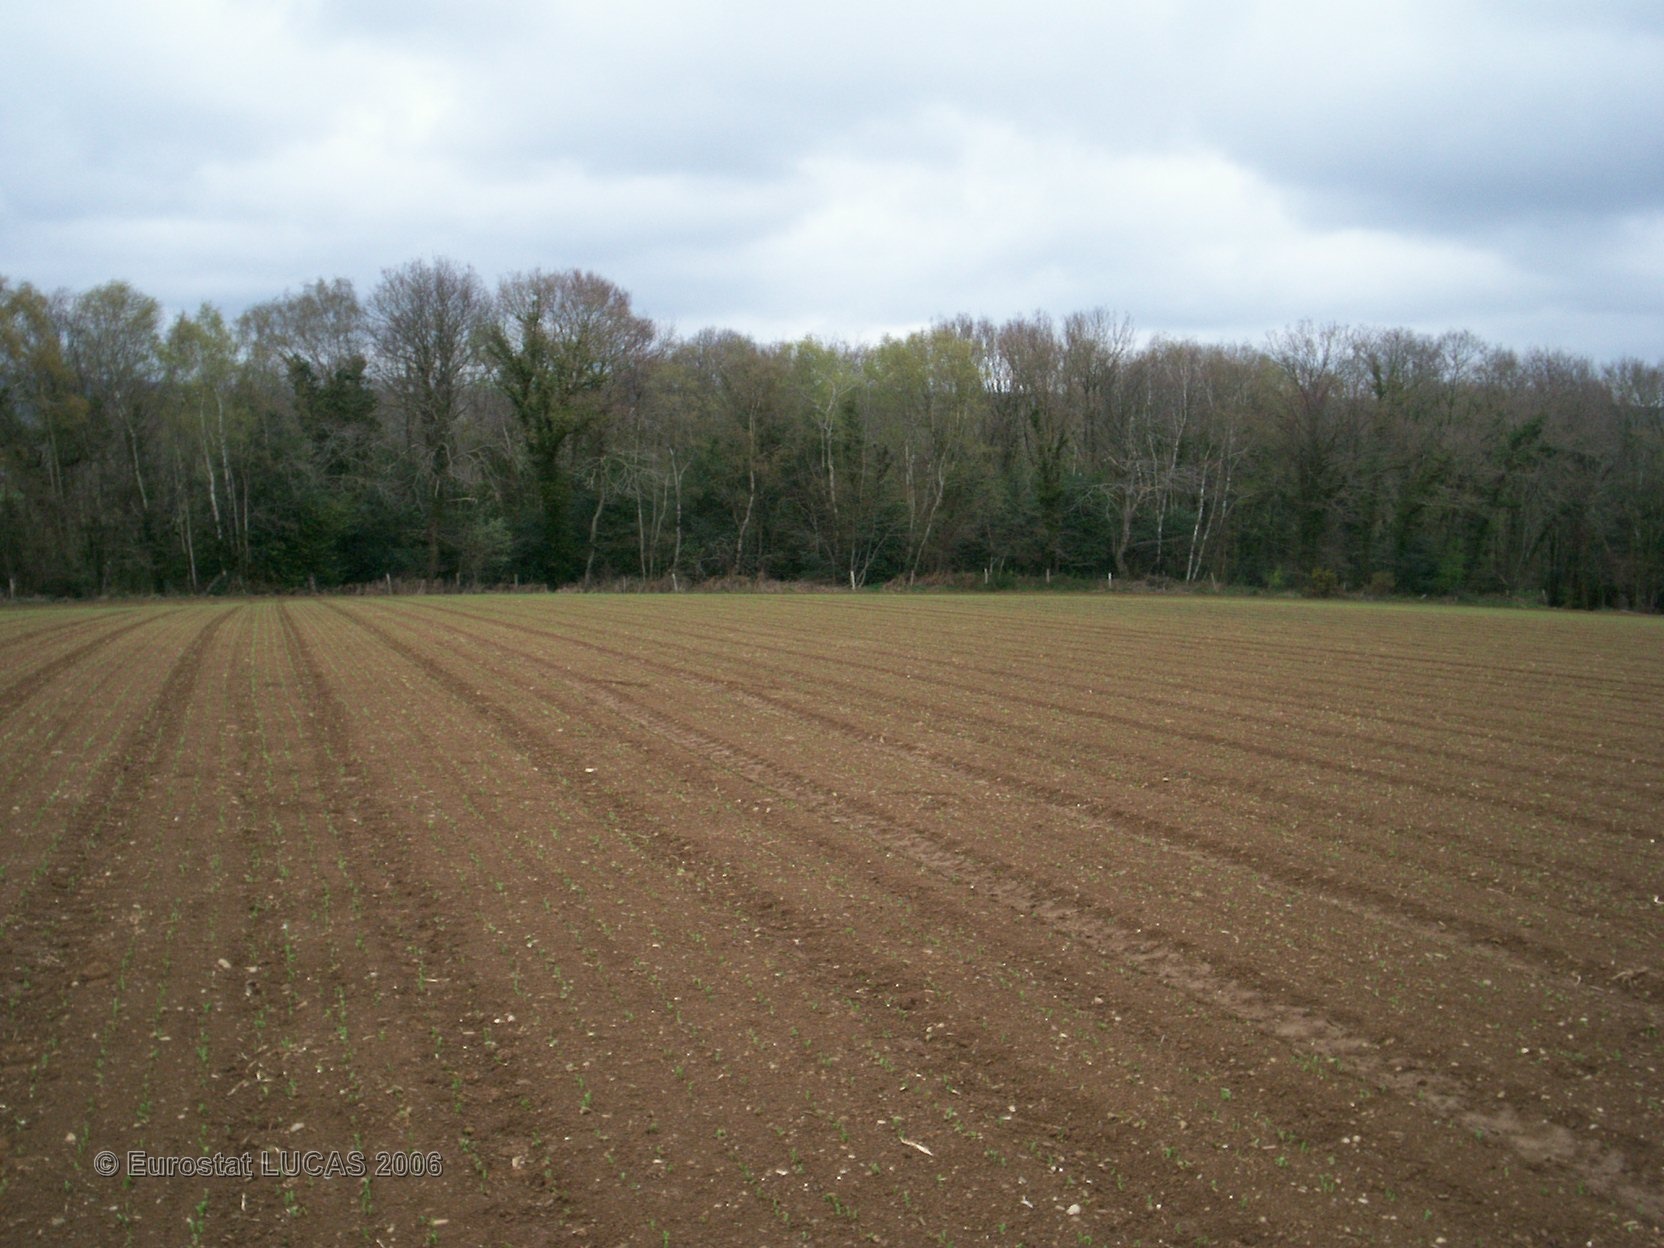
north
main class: Cropland
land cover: Other fresh vegetables
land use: Agriculture (excluding fallow land and kitchen gardens)
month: April
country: FR
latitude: 47.7760
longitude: -2.8622
